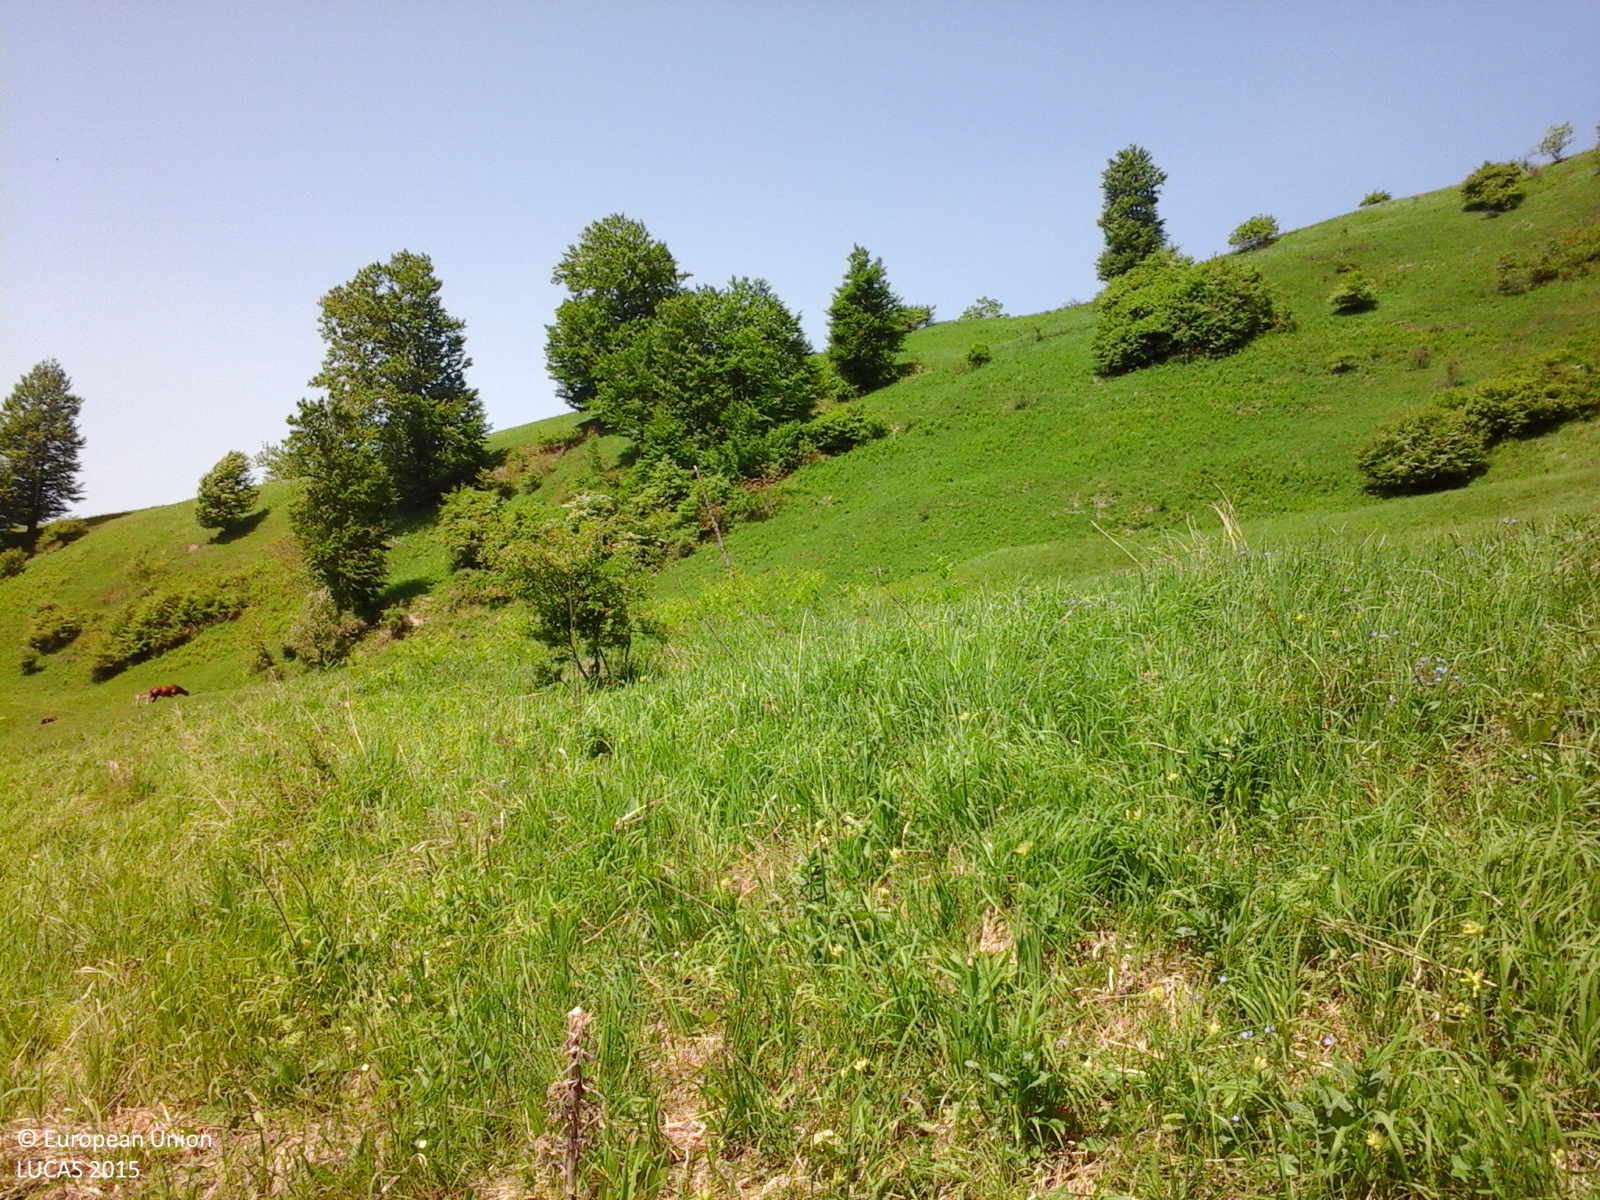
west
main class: Grassland
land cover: Grassland with sparse tree/shrub cover
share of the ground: > 75 %
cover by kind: herbaceous plants 85 %, shrubs 10 %, broadleaved forest trees 5 %
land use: Agriculture (excluding fallow land and kitchen gardens)
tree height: > 5 m
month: May
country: RO
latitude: 45.4306
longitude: 26.2361
